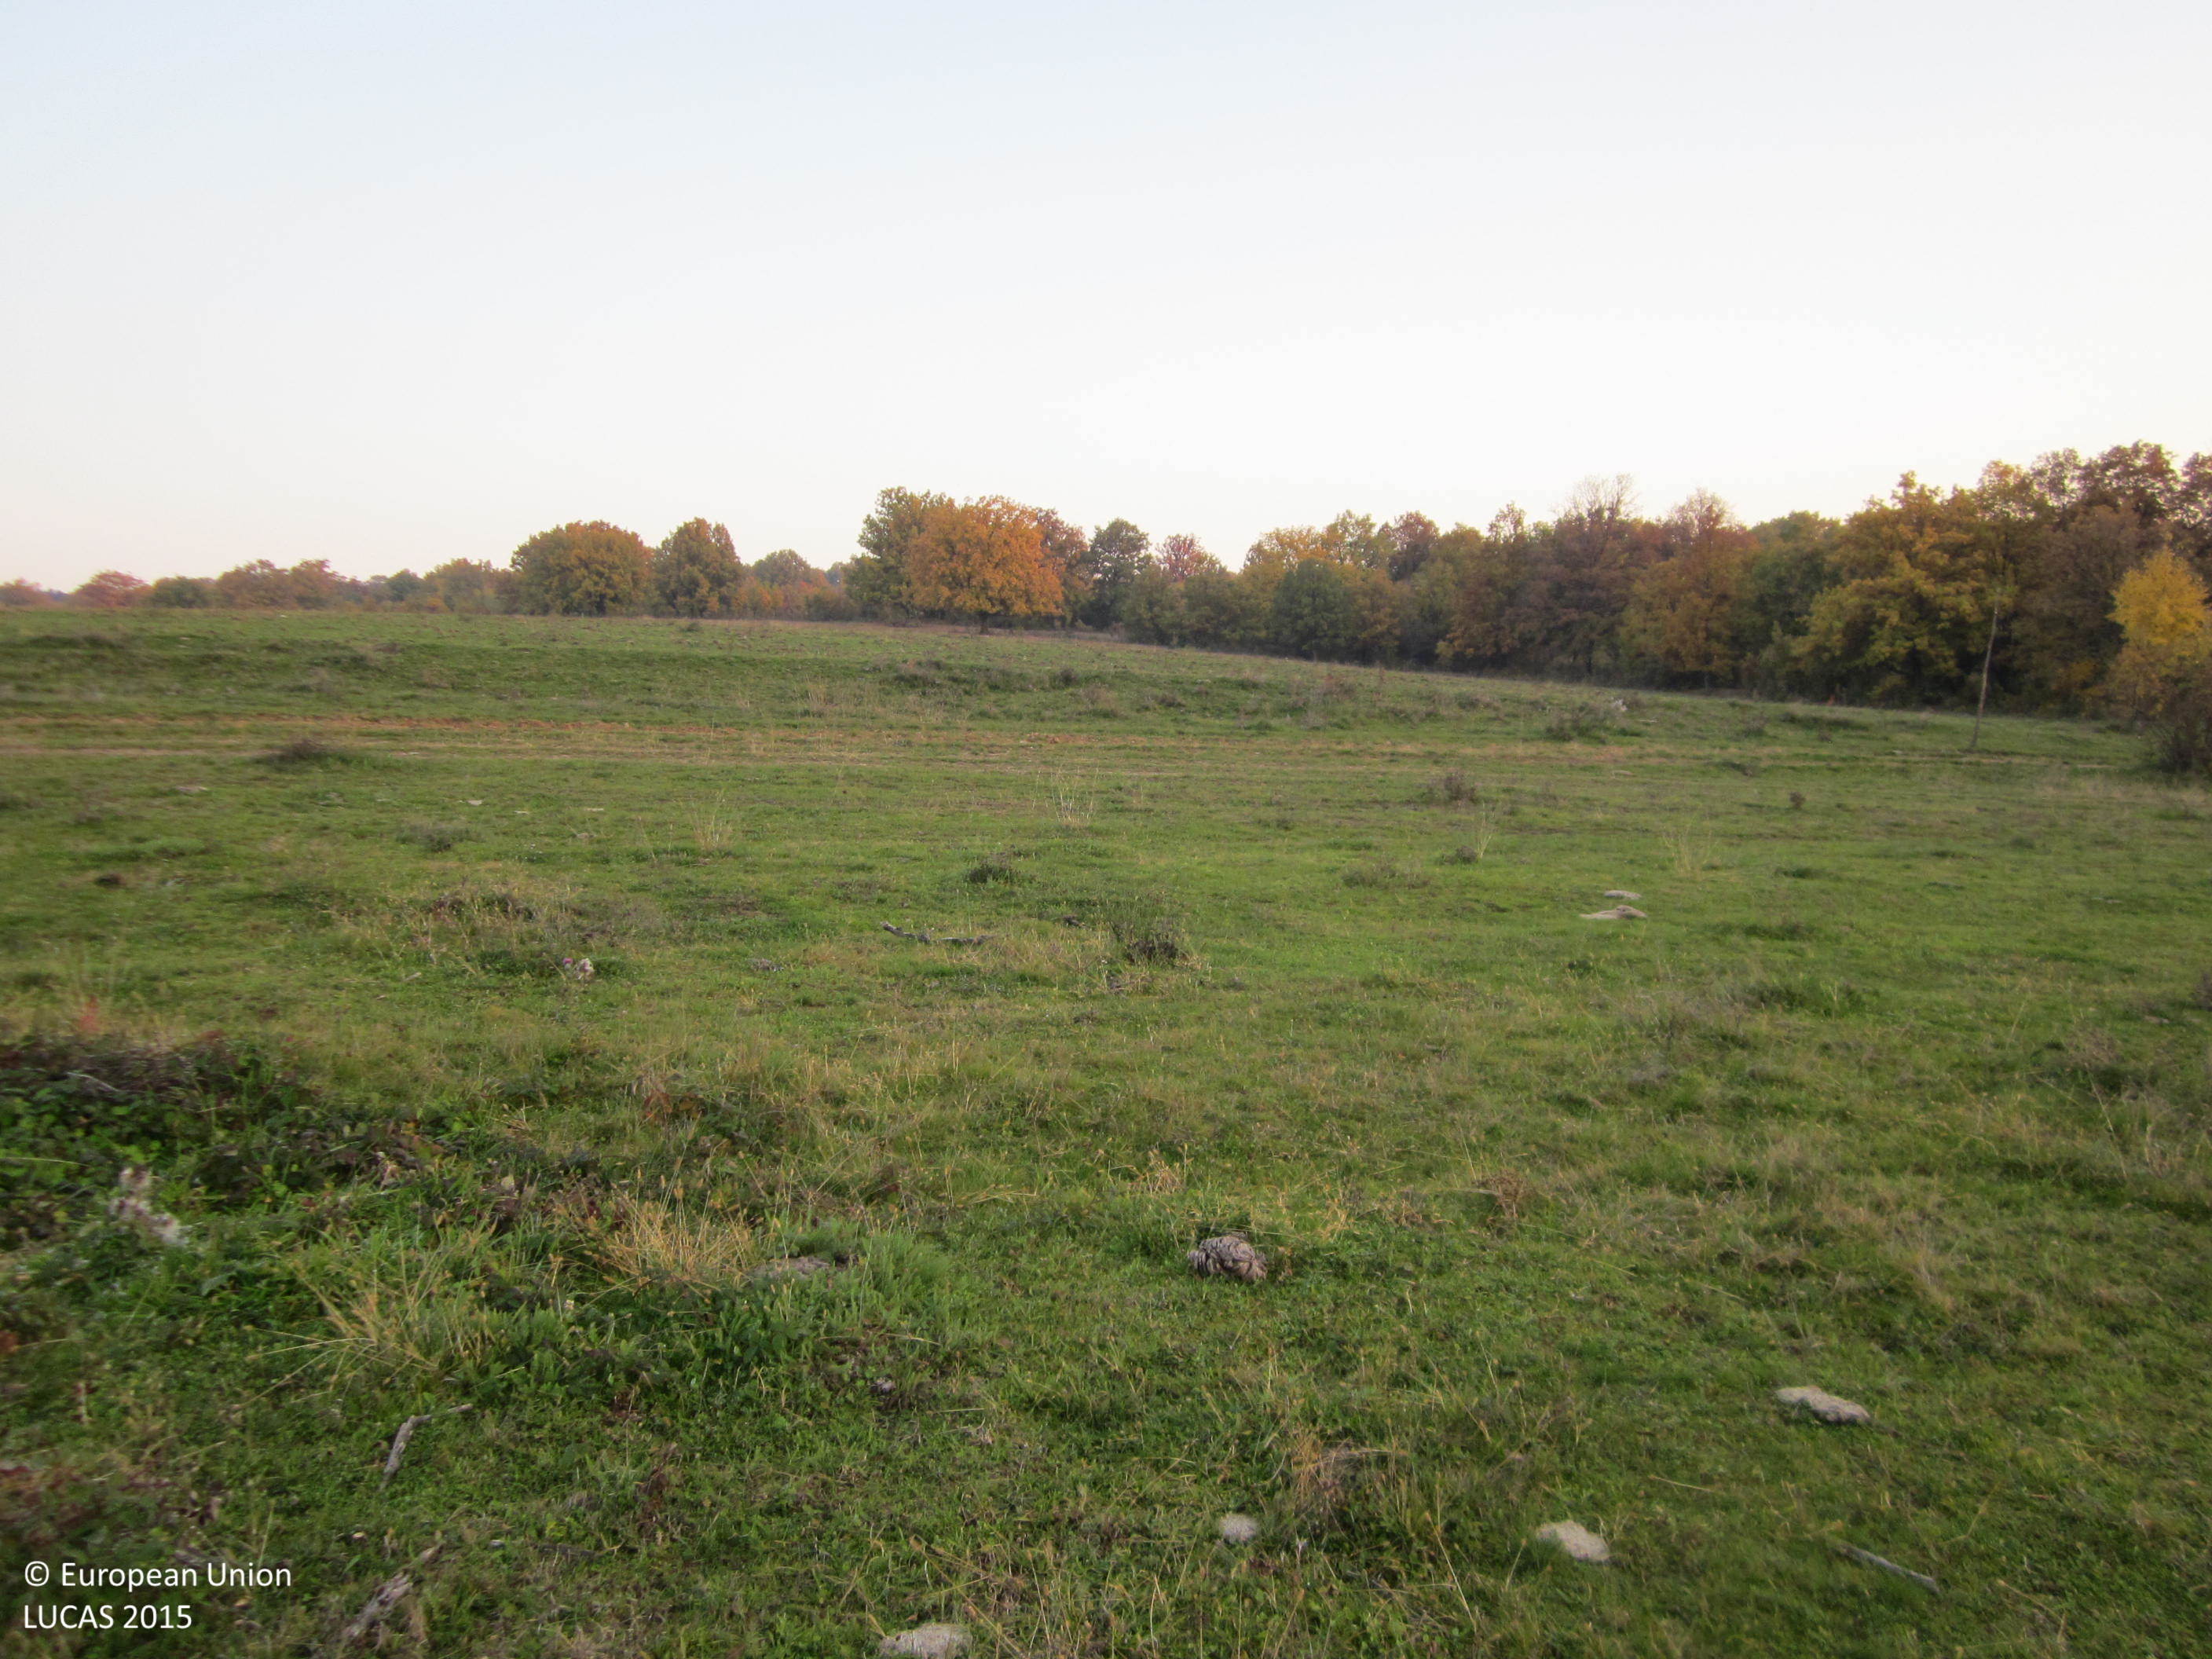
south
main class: Grassland
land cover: Grassland without tree/shrub cover
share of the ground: > 75 %
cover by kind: herbaceous plants 100 %
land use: Agriculture (excluding fallow land and kitchen gardens)
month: November
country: BG
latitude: 42.4993
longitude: 24.6435
